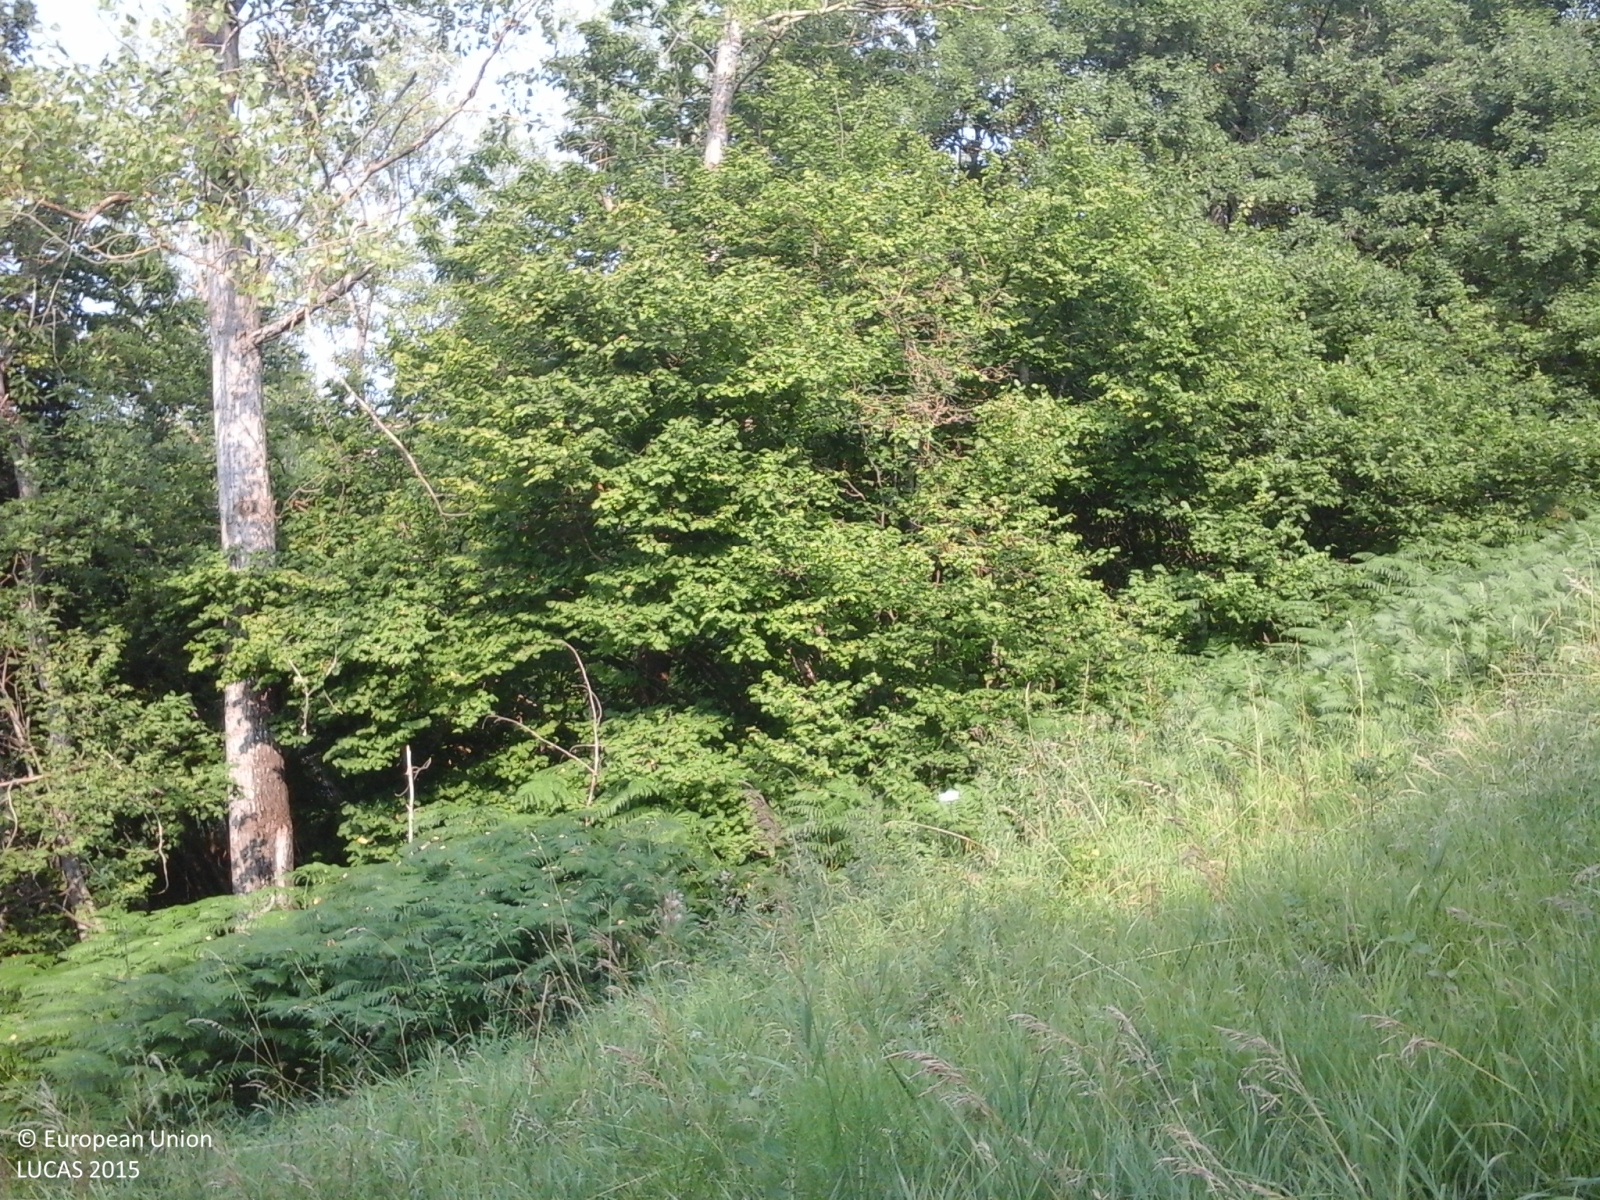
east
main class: Woodland
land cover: Broadleaved woodland
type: thermophilous deciduous forest
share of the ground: > 75 %
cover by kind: broadleaved forest trees 100 %
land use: Forestry
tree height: > 5 m
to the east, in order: Broadleaved woodland; Grassland without tree/shrub cover; Broadleaved woodland
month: July
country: IT
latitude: 44.3487
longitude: 10.6133
